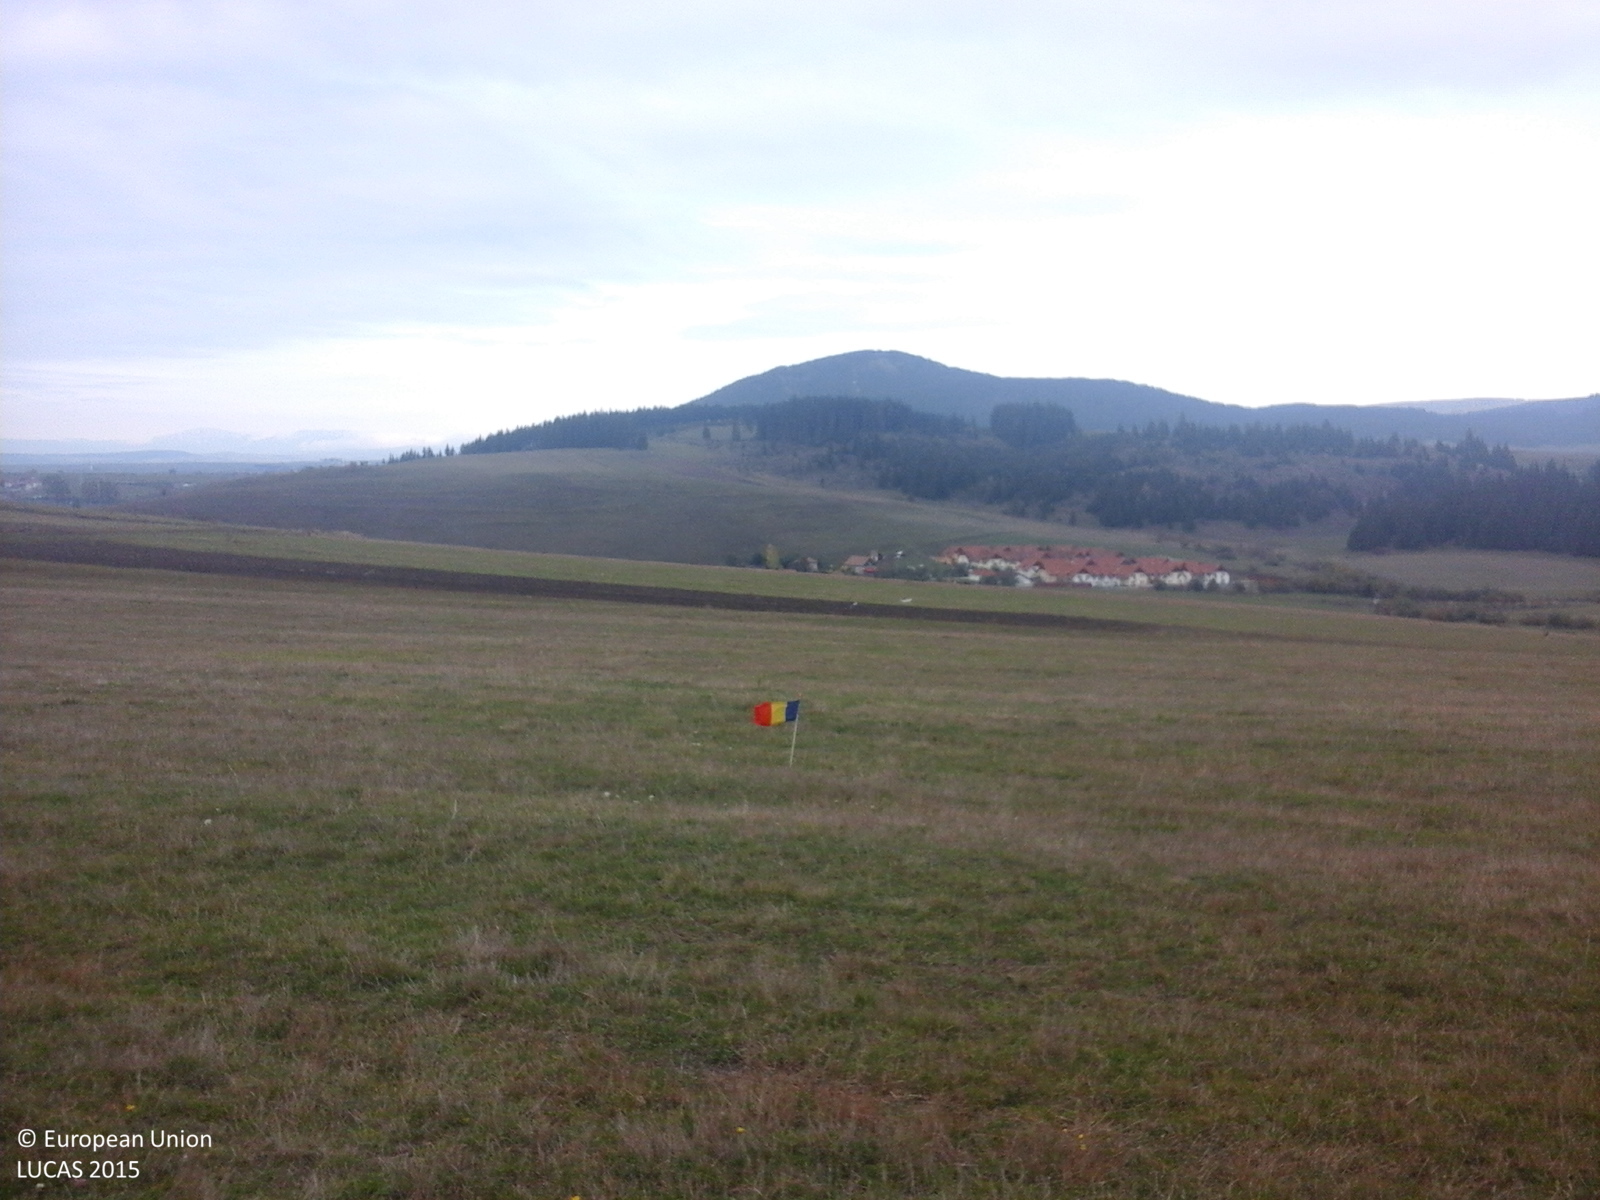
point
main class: Grassland
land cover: Grassland without tree/shrub cover
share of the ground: > 75 %
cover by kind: herbaceous plants 100 %
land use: Agriculture (excluding fallow land and kitchen gardens)
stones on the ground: < 10 %
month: October
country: RO
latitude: 46.3379
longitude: 25.8223
